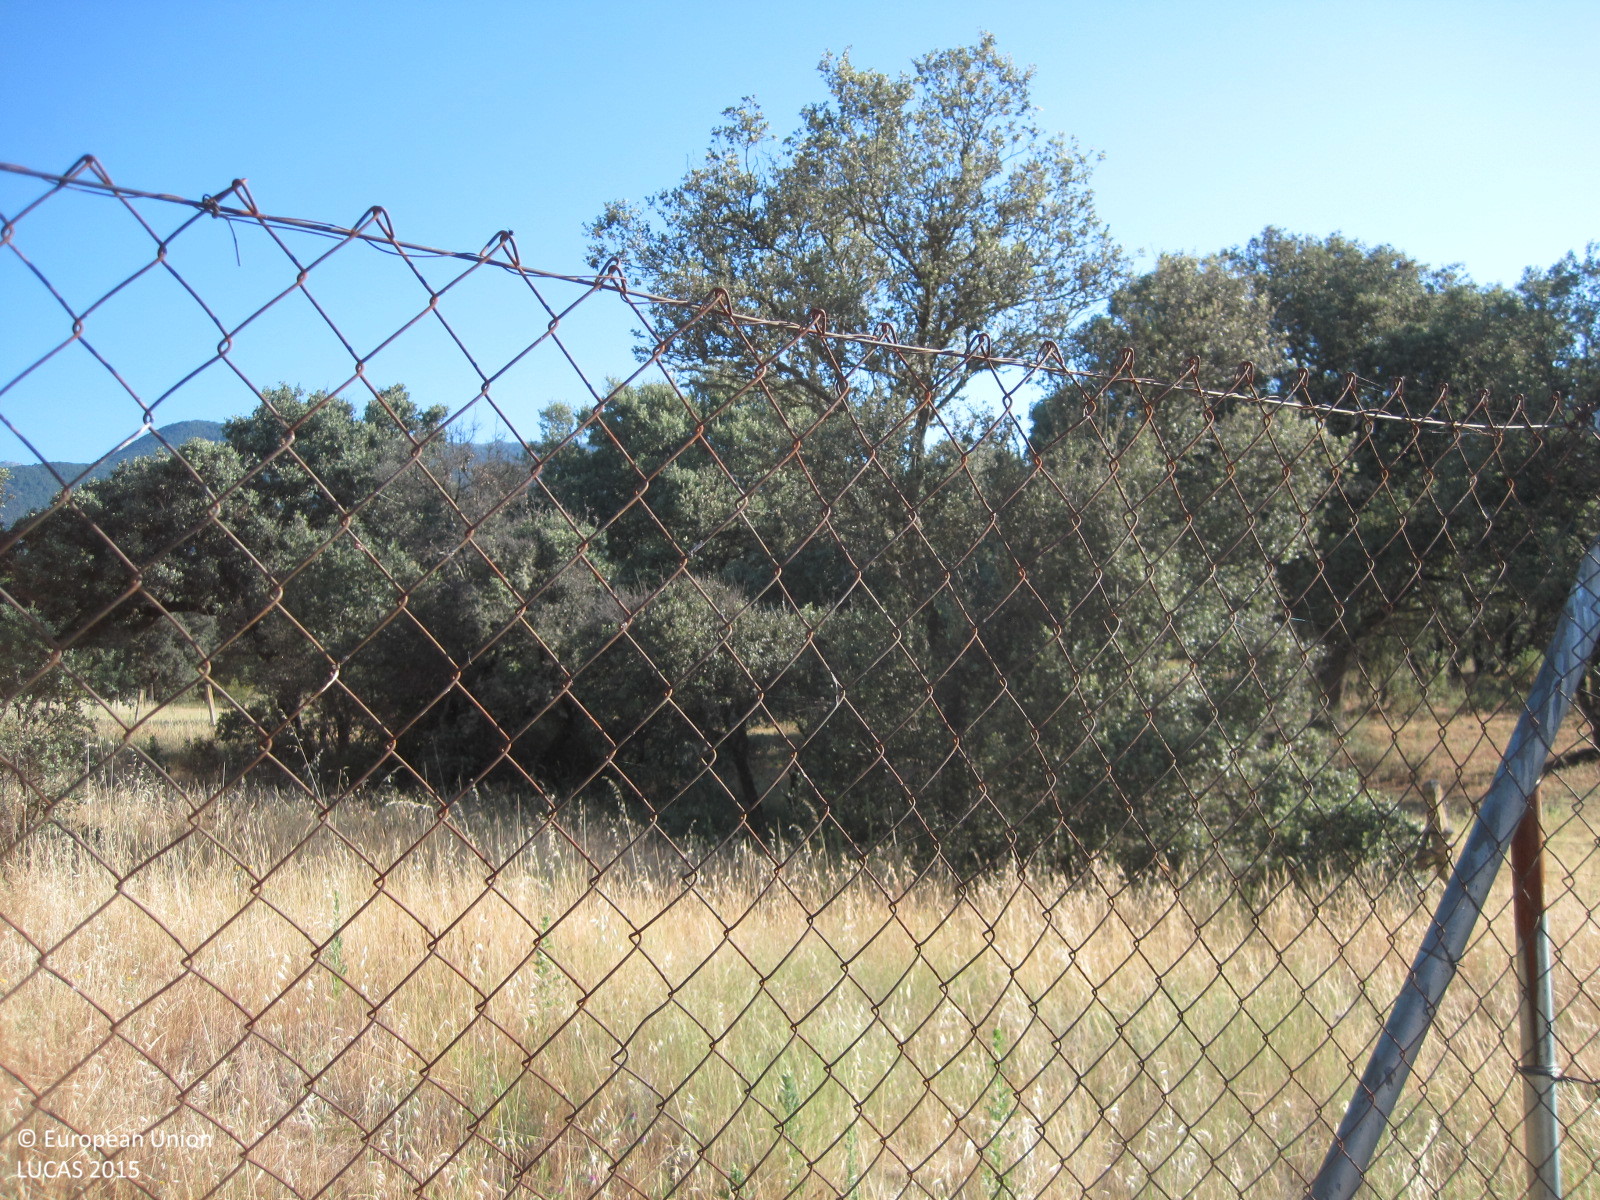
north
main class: Grassland
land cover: Grassland with sparse tree/shrub cover
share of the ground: > 75 %
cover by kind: herbaceous plants 95 %, broadleaved forest trees 5 %
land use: Agriculture (excluding fallow land and kitchen gardens)
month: May
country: ES
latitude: 40.2566
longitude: -4.8072
